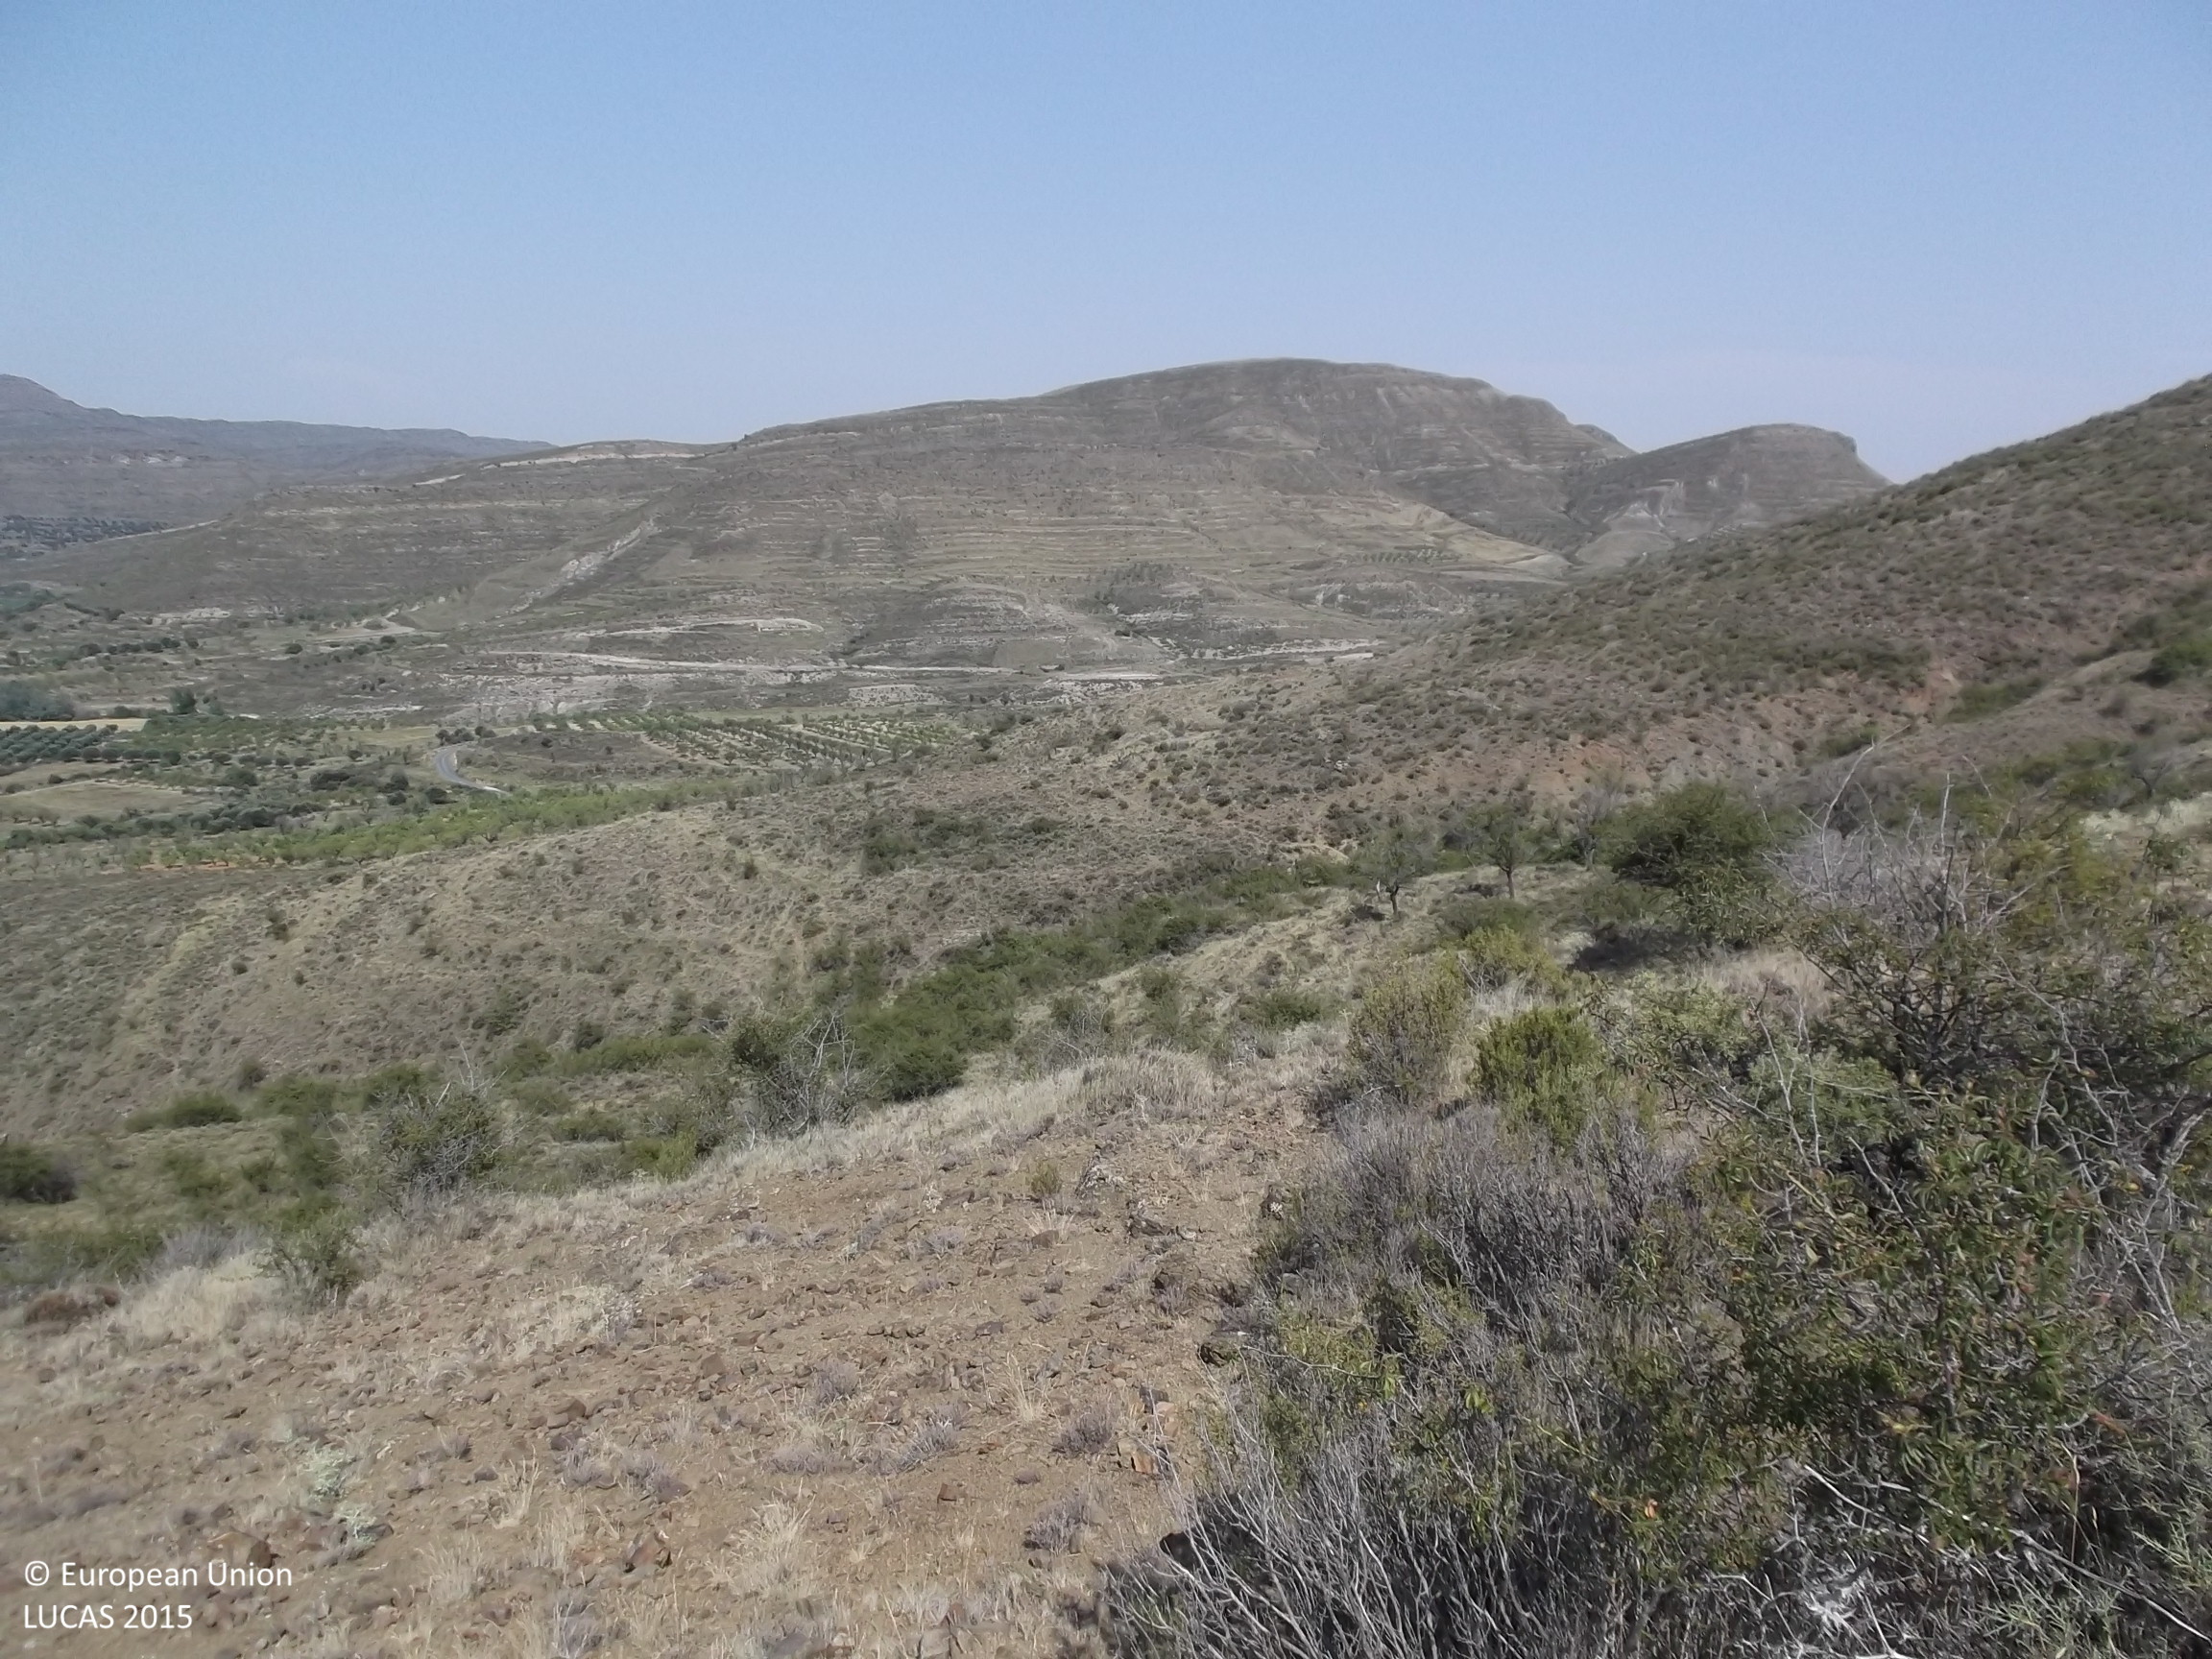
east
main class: Shrubland
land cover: Shrubland without tree cover
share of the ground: 25 - 50 %
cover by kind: shrubs 40 %, herbaceous plants 30 %, unconsolidated bare surface 30 %
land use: Agriculture (excluding fallow land and kitchen gardens)
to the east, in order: Shrubland without tree cover; Shrubland with sparse tree cover
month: July
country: ES
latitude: 42.0761
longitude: -2.0634
